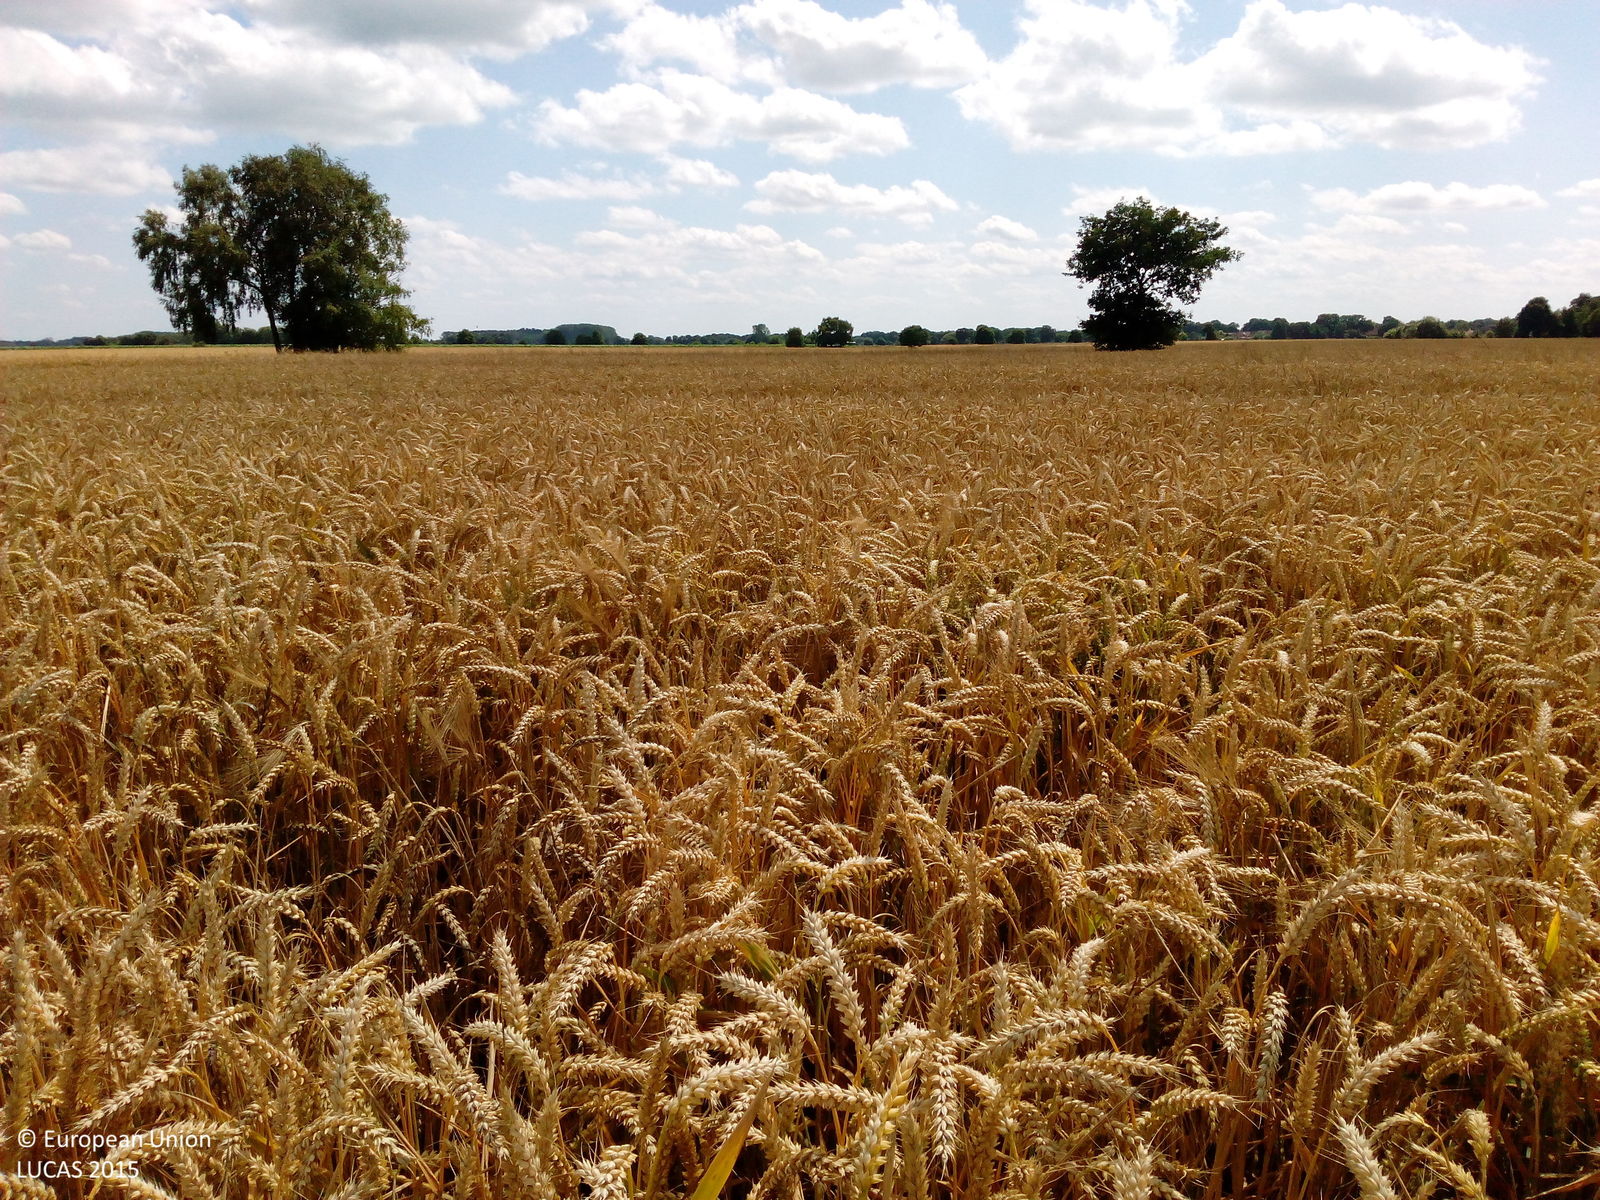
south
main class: Cropland
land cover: Common wheat
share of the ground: > 75 %
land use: Agriculture (excluding fallow land and kitchen gardens)
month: July
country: DE
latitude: 53.1509
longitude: 7.9521
